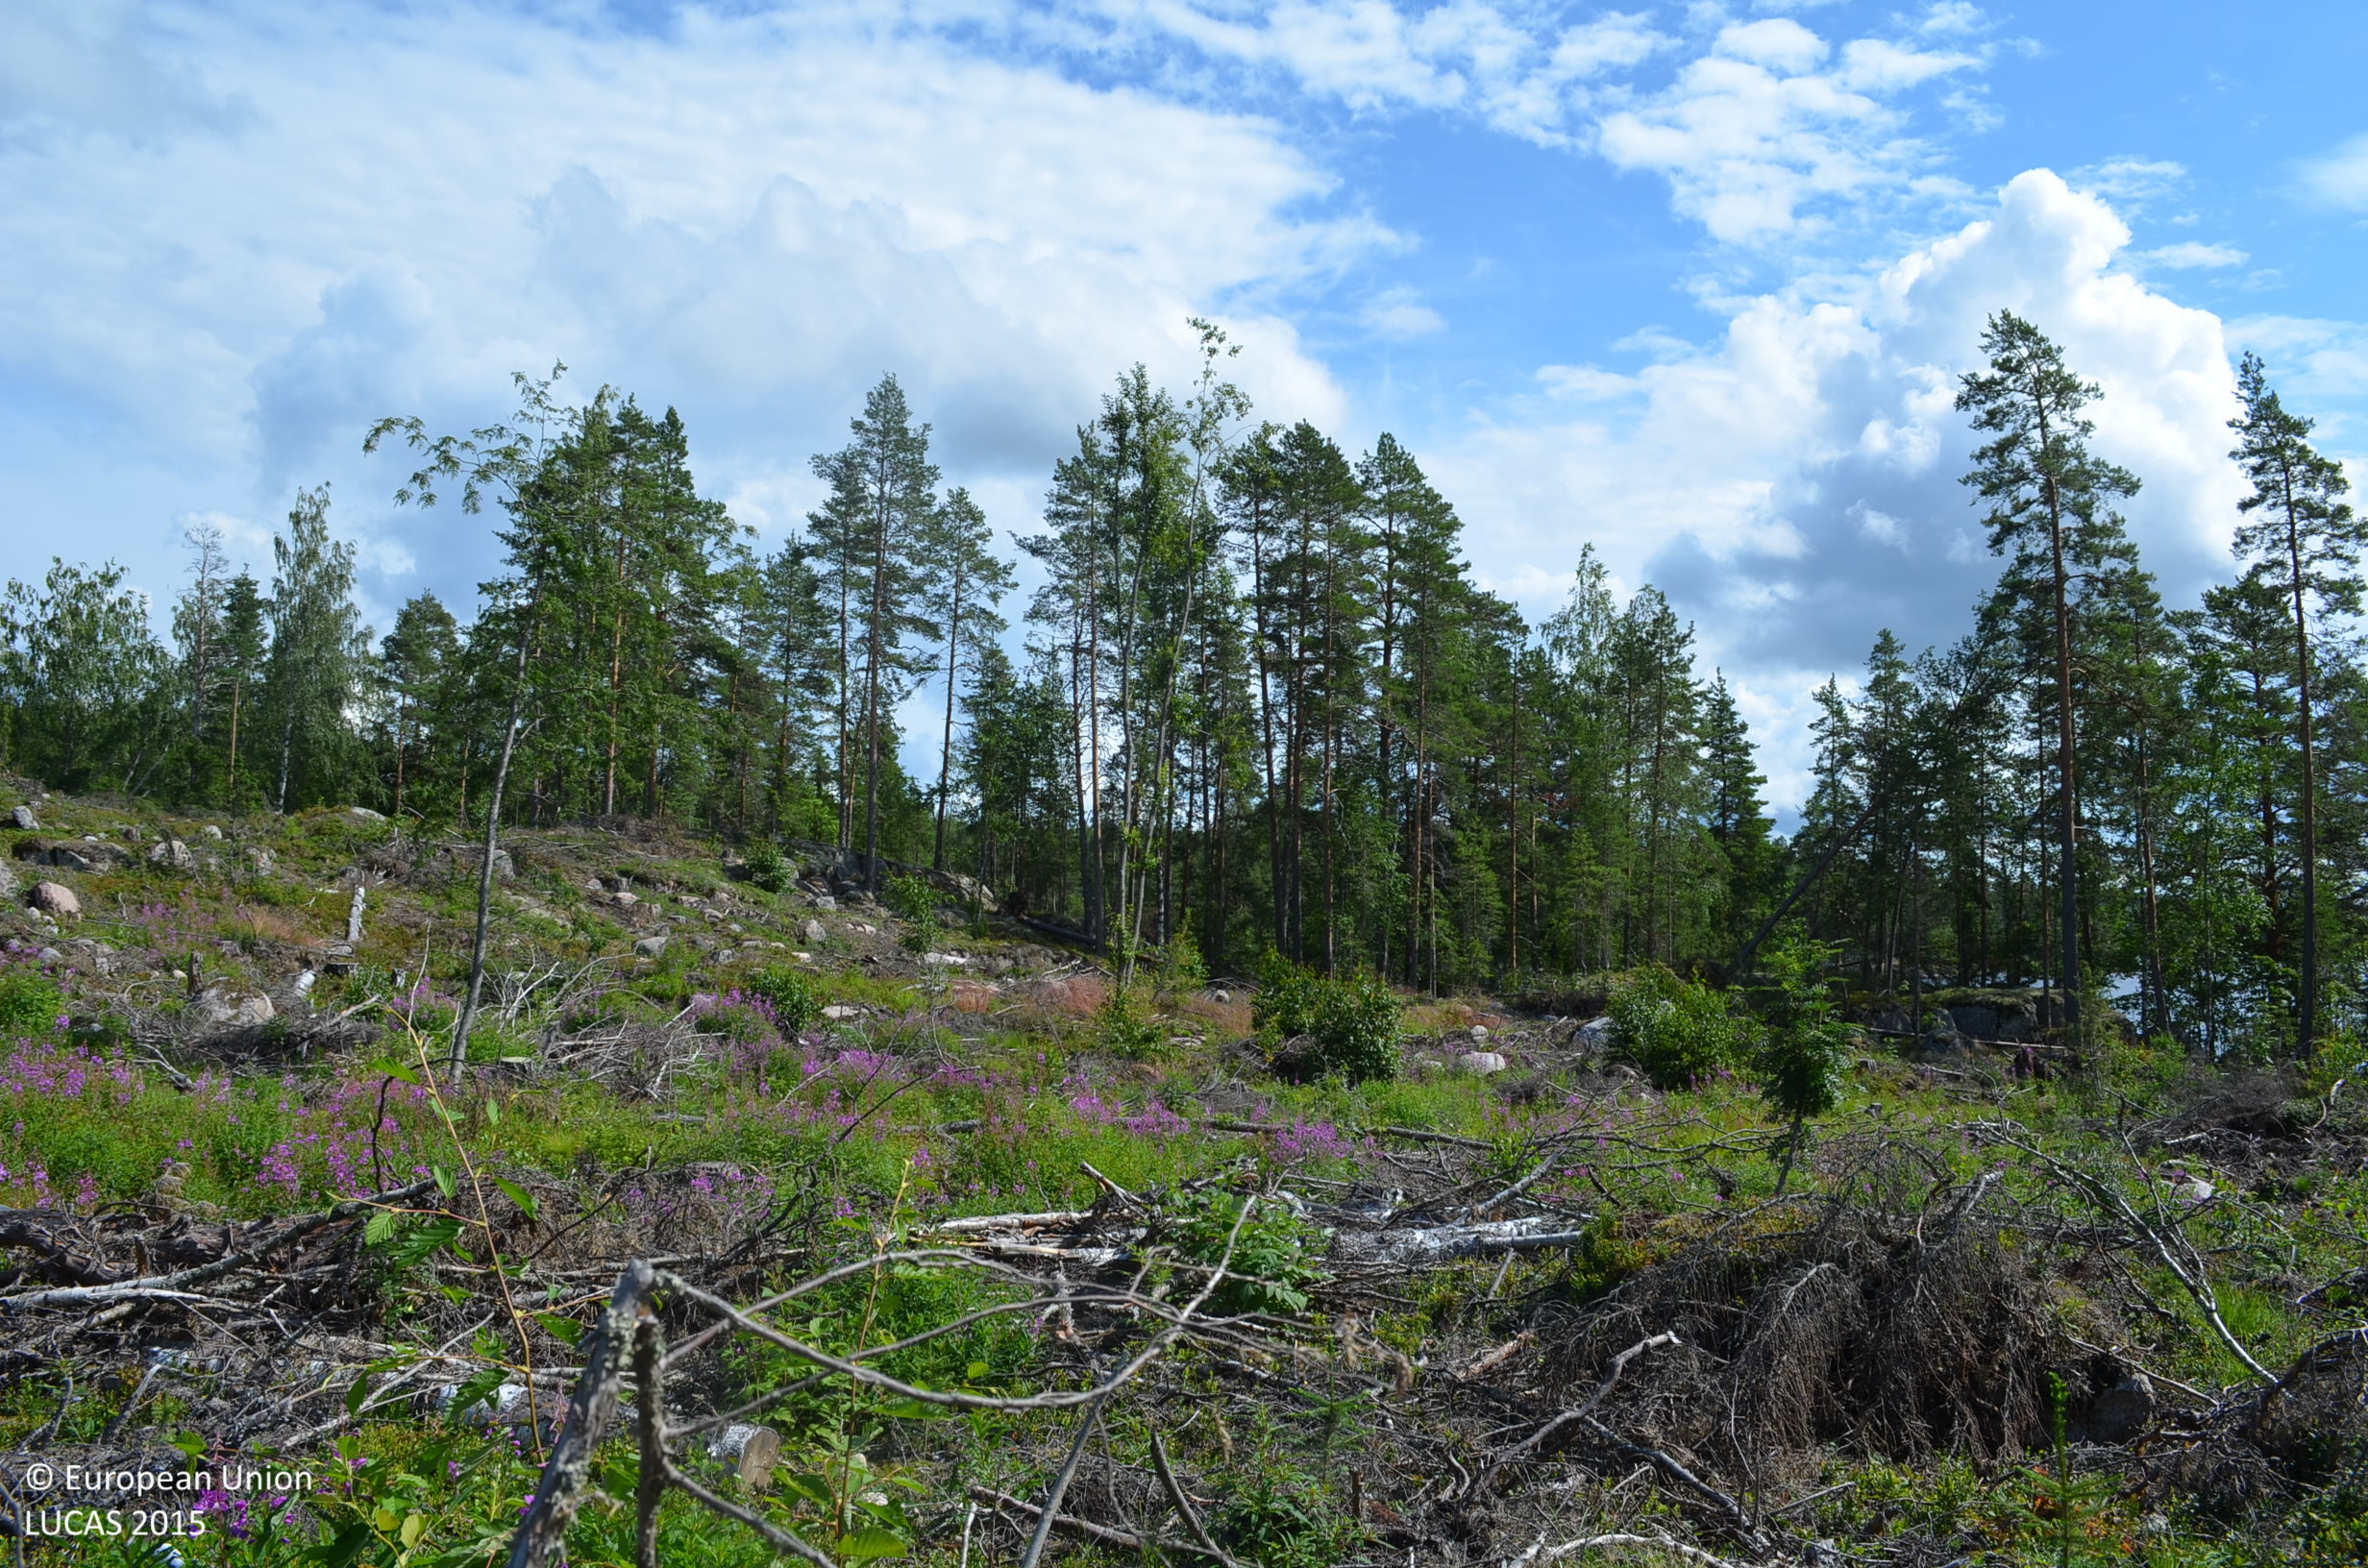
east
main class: Shrubland
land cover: Shrubland with sparse tree cover
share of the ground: 25 - 50 %
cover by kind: shrubs 40 %, herbaceous plants 15 %, consolidated bare surface 15 %, broadleaved forest trees 5 %
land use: Forestry
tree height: < 5 m
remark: Clear cut
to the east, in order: Shrubland with sparse tree cover; Pine dominated coniferous woodland; Grassland with sparse tree/shrub cover; Ponds and wetlands; Inland fresh water bodies; Rocks and stones; Inland fresh water bodies; Pine dominated coniferous woodland; Inland fresh water bodies
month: July
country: FI
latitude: 61.9975
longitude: 24.1195
